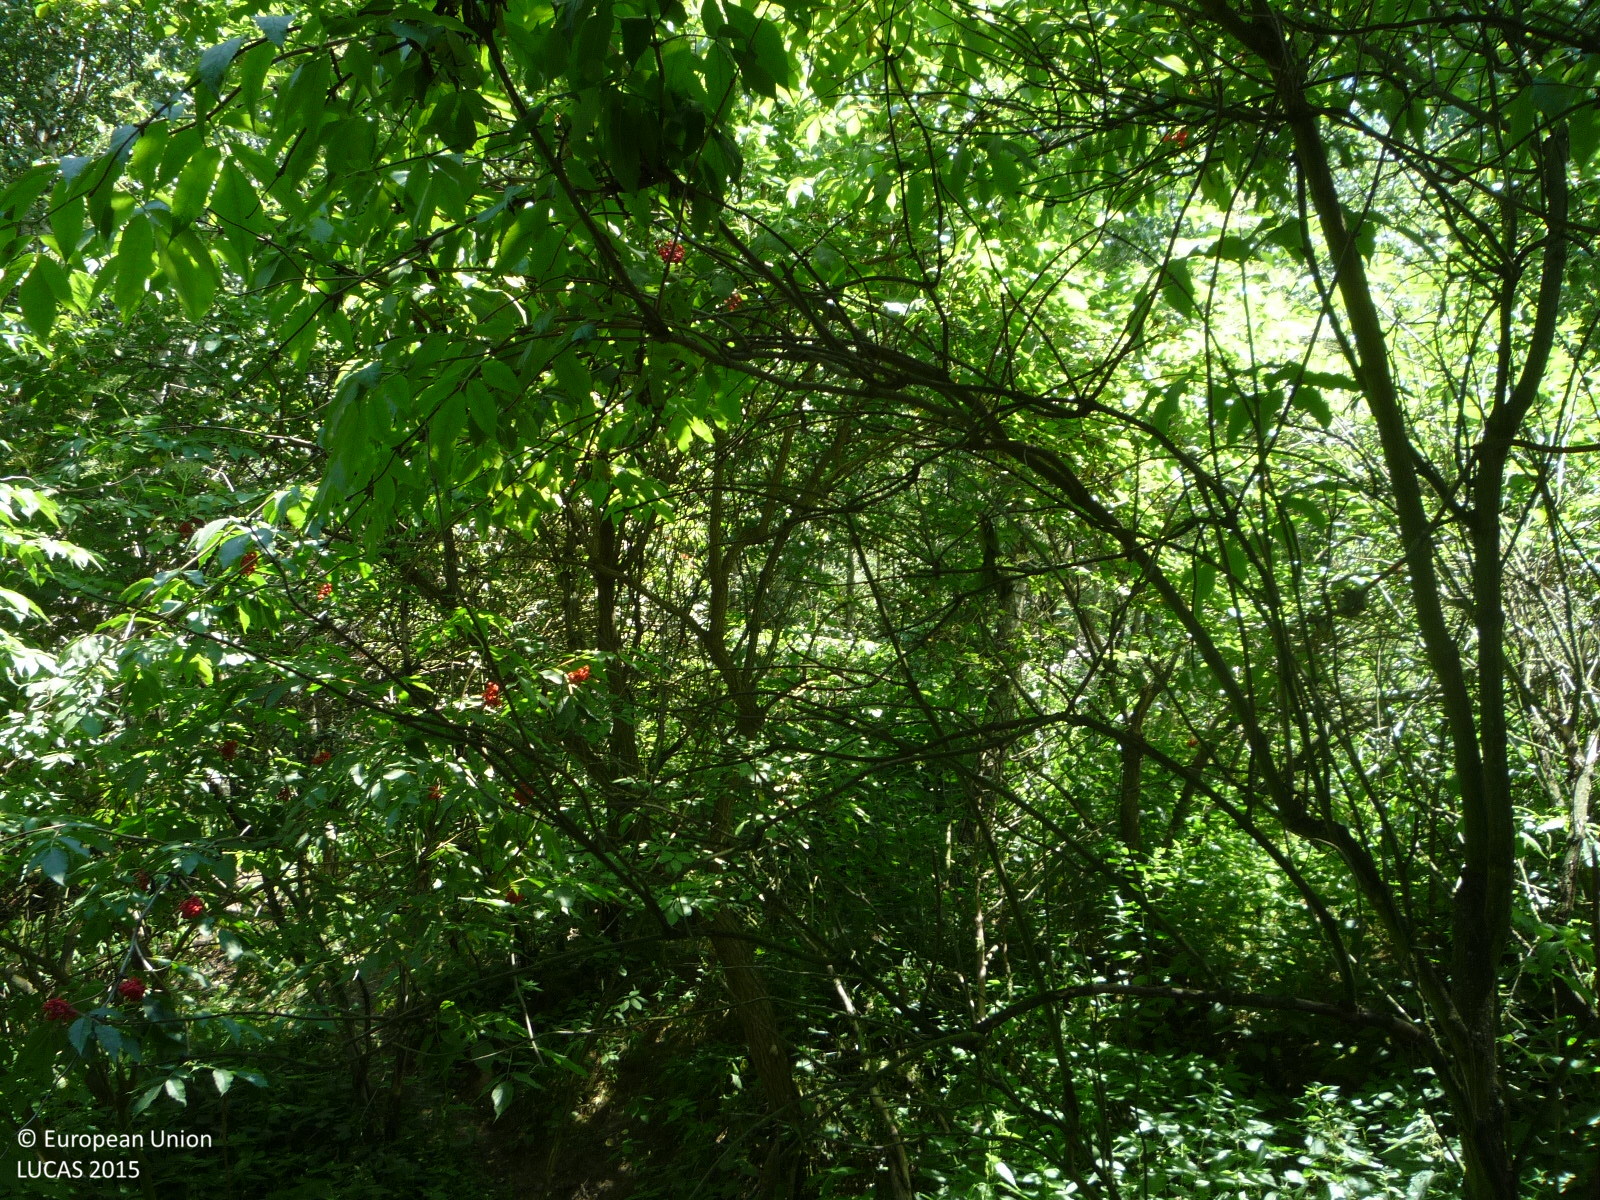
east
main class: Woodland
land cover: Broadleaved woodland
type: mesophytic deciduous forest
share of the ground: > 75 %
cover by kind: broadleaved forest trees 85 %, shrubs 10 %, herbaceous plants 5 %
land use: Semi-natural and natural areas not in use
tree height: > 5 m
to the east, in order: Broadleaved woodland; Other mixed woodland; Rocks and stones; Broadleaved woodland; Spontaneously vegetated surfaces; Tracks; Spontaneously vegetated surfaces; Other mixed woodland
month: July
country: CZ
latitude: 50.4200
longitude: 14.4915
